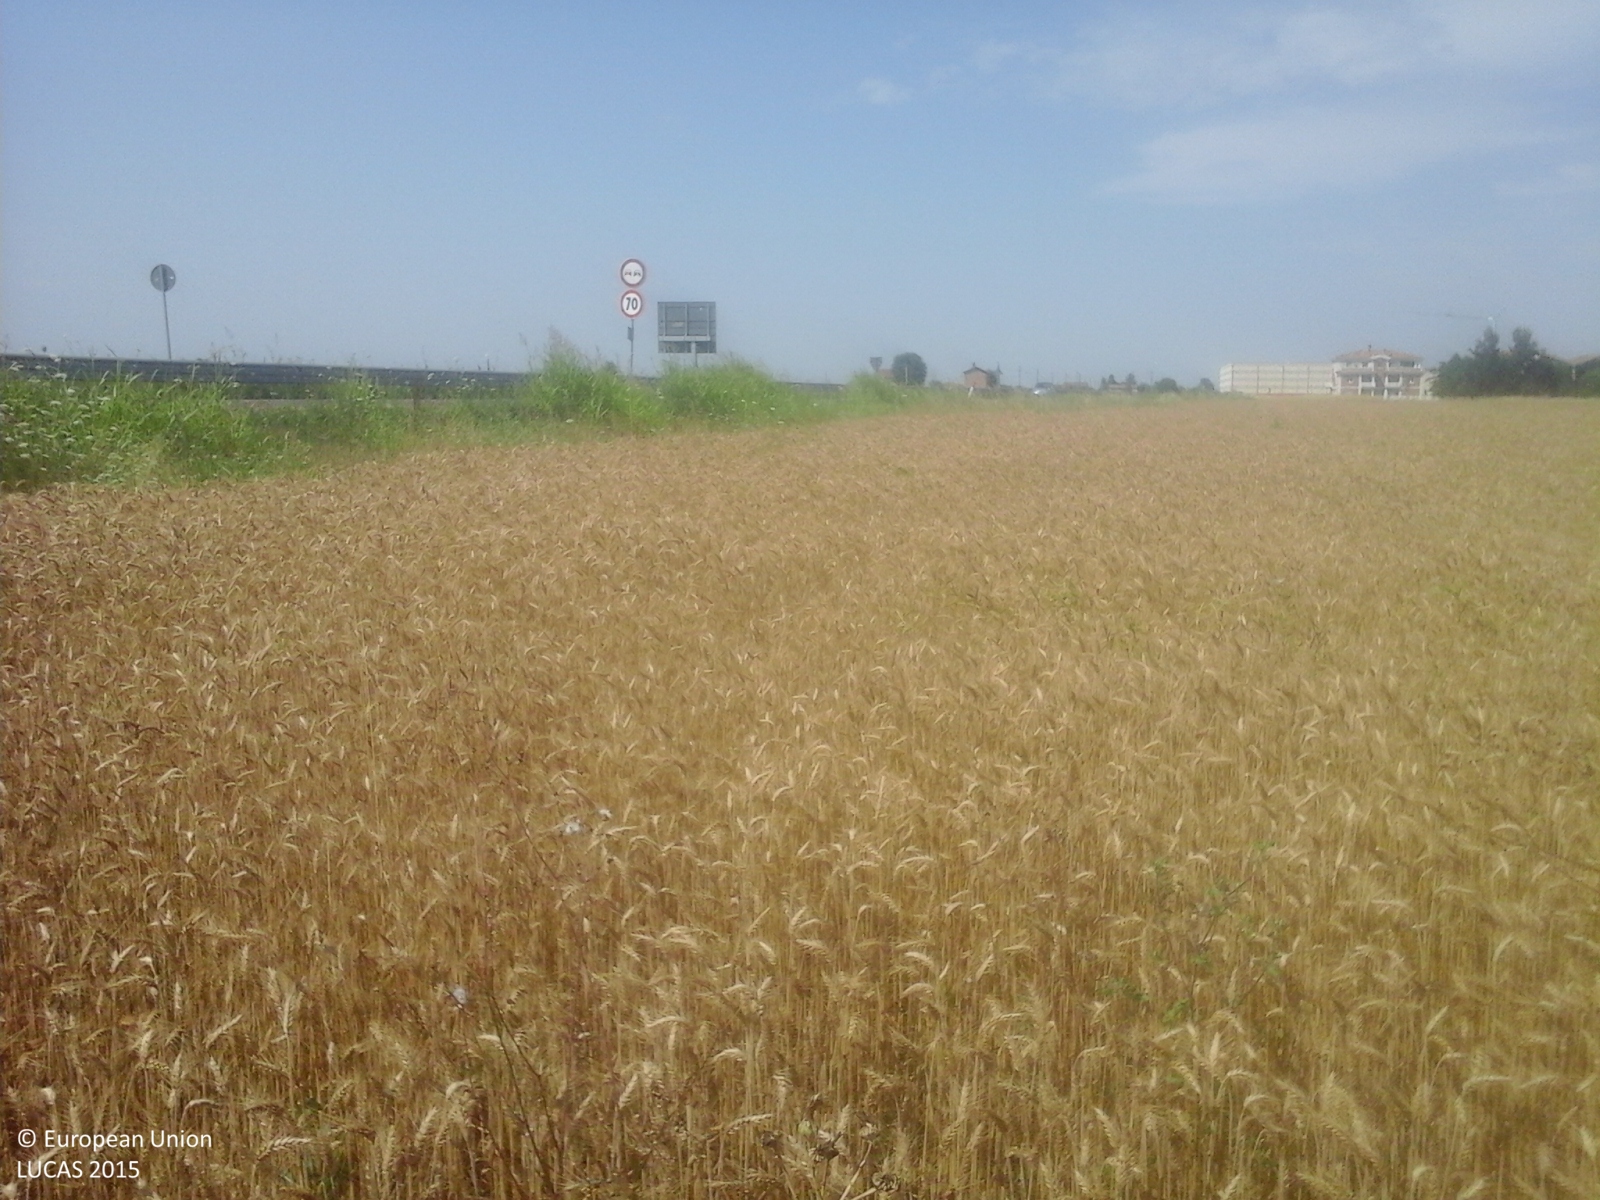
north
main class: Cropland
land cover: Common wheat
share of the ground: > 75 %
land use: Agriculture (excluding fallow land and kitchen gardens)
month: June
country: IT
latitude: 44.6880
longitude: 11.0451
